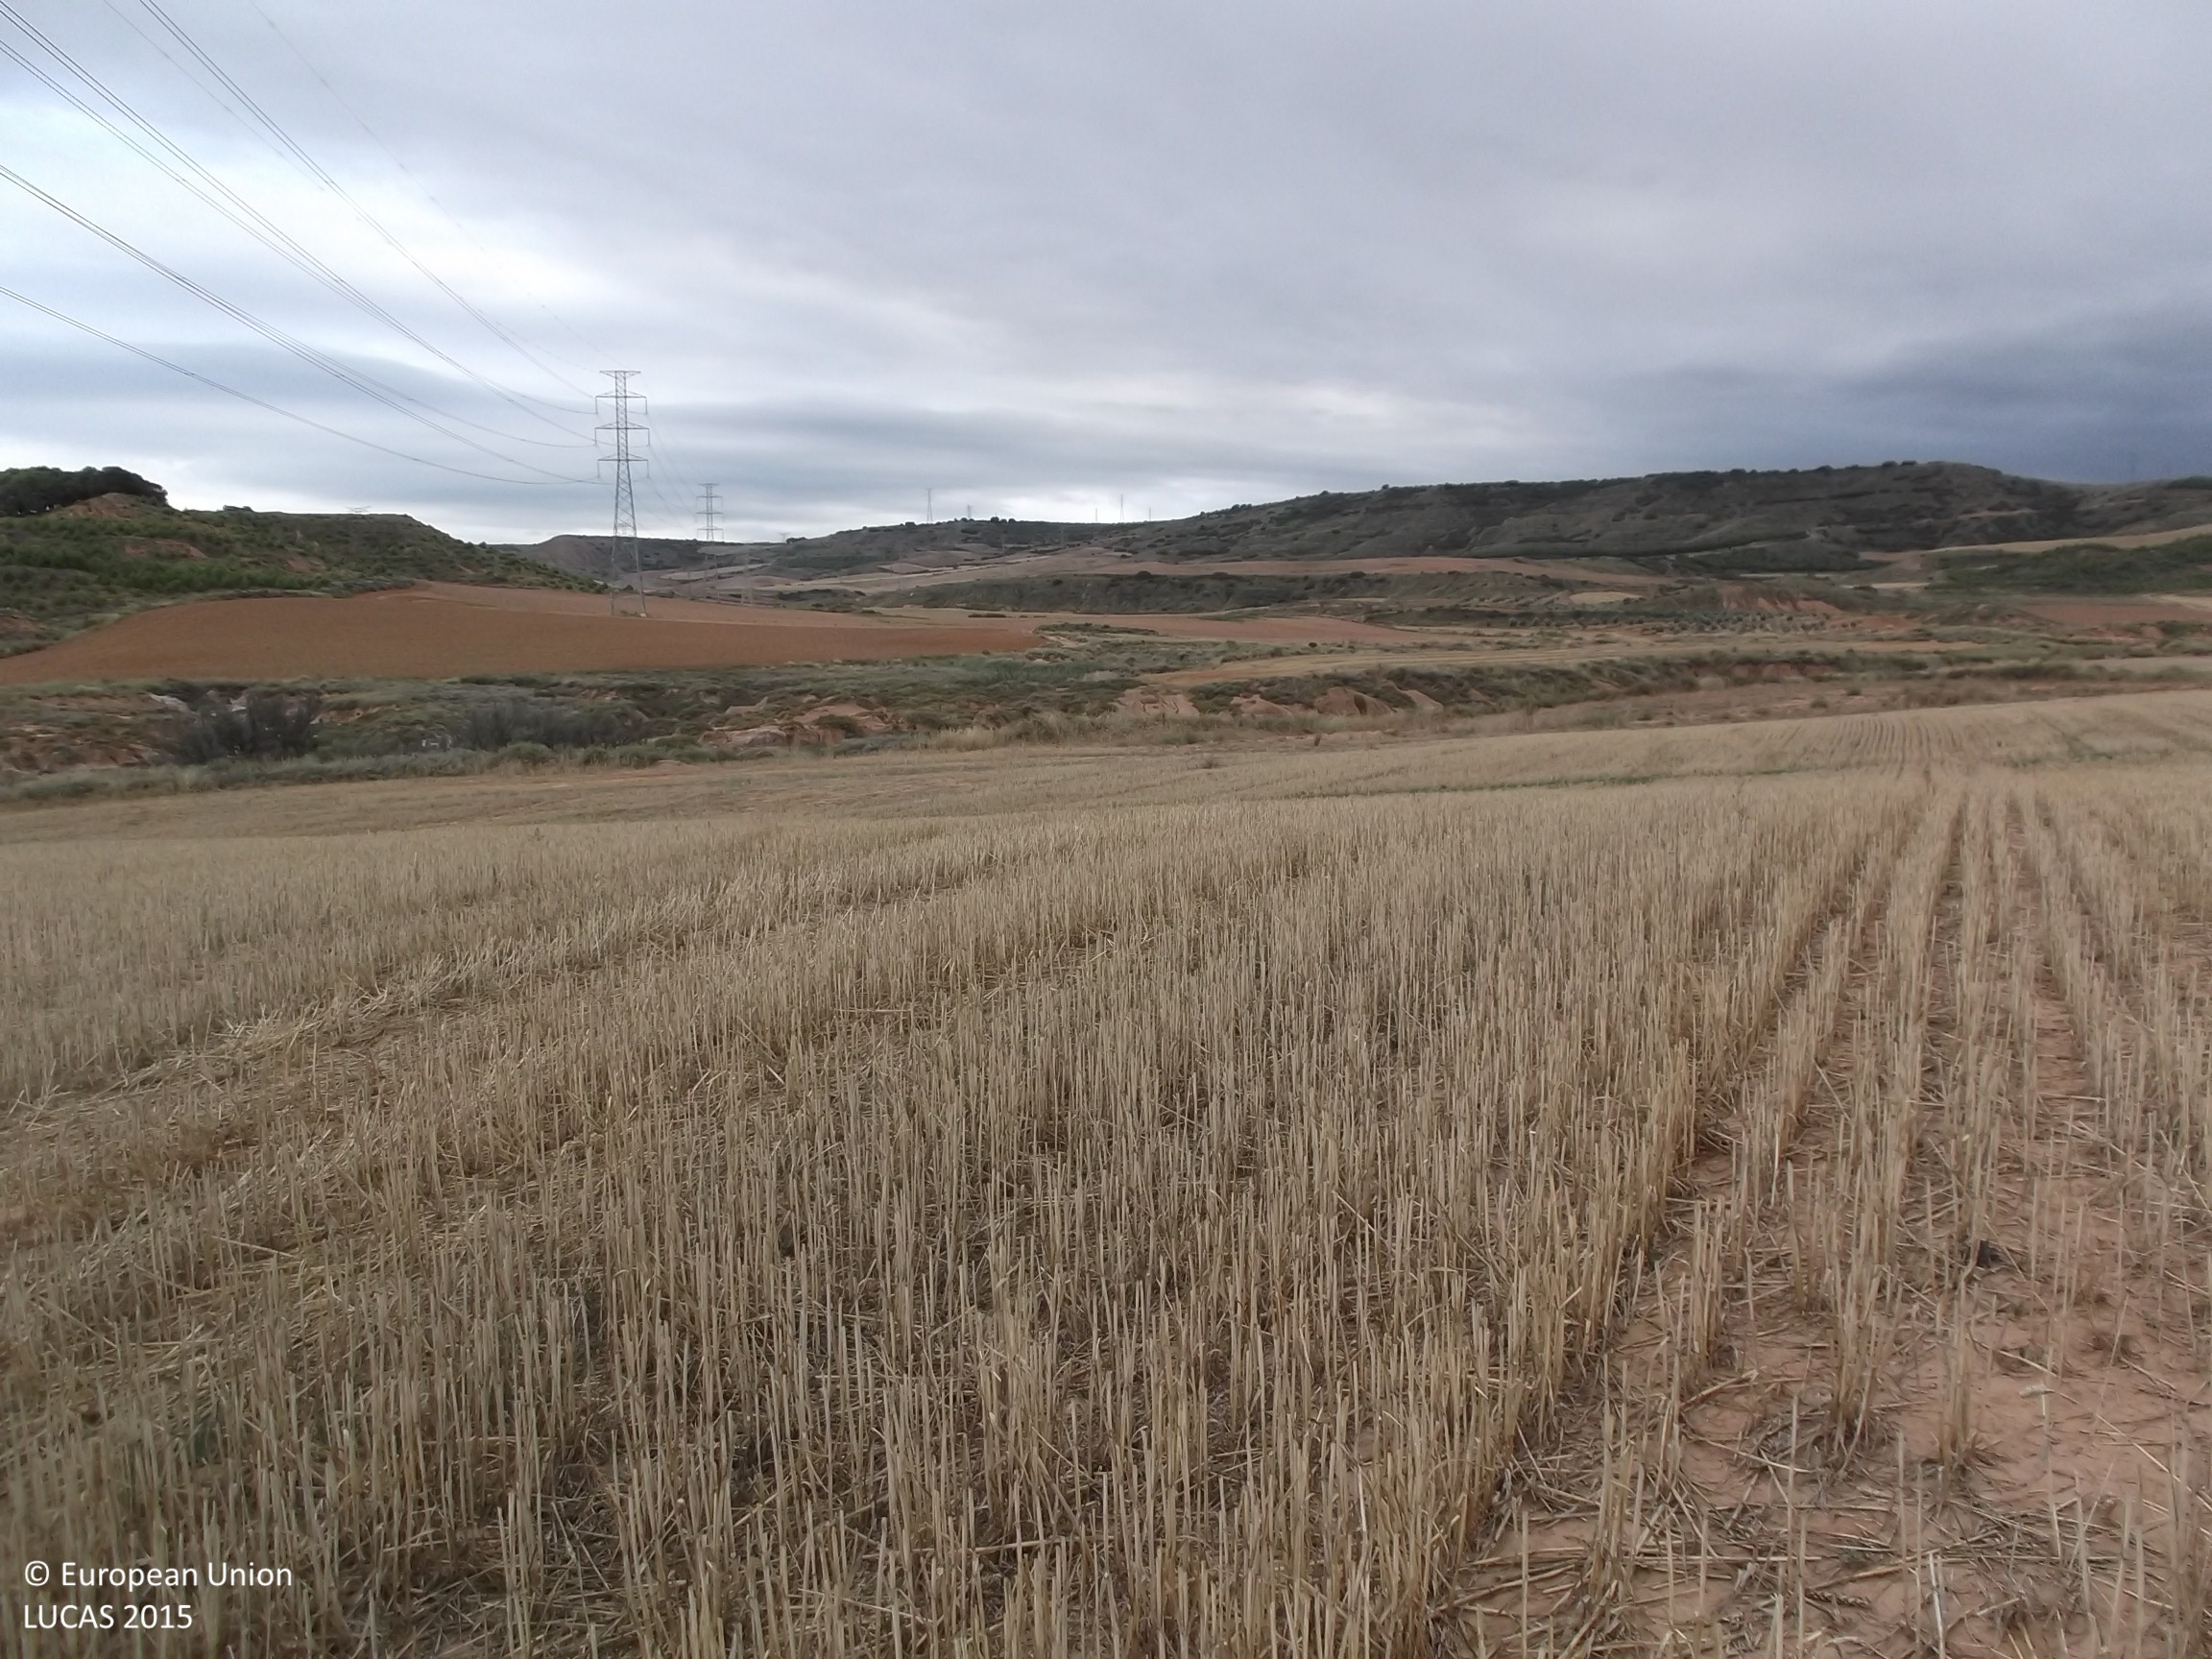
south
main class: Cropland
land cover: Common wheat
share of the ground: < 10 %
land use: Agriculture (excluding fallow land and kitchen gardens)
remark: Harvested field
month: July
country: ES
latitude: 42.3998
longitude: -2.2518
